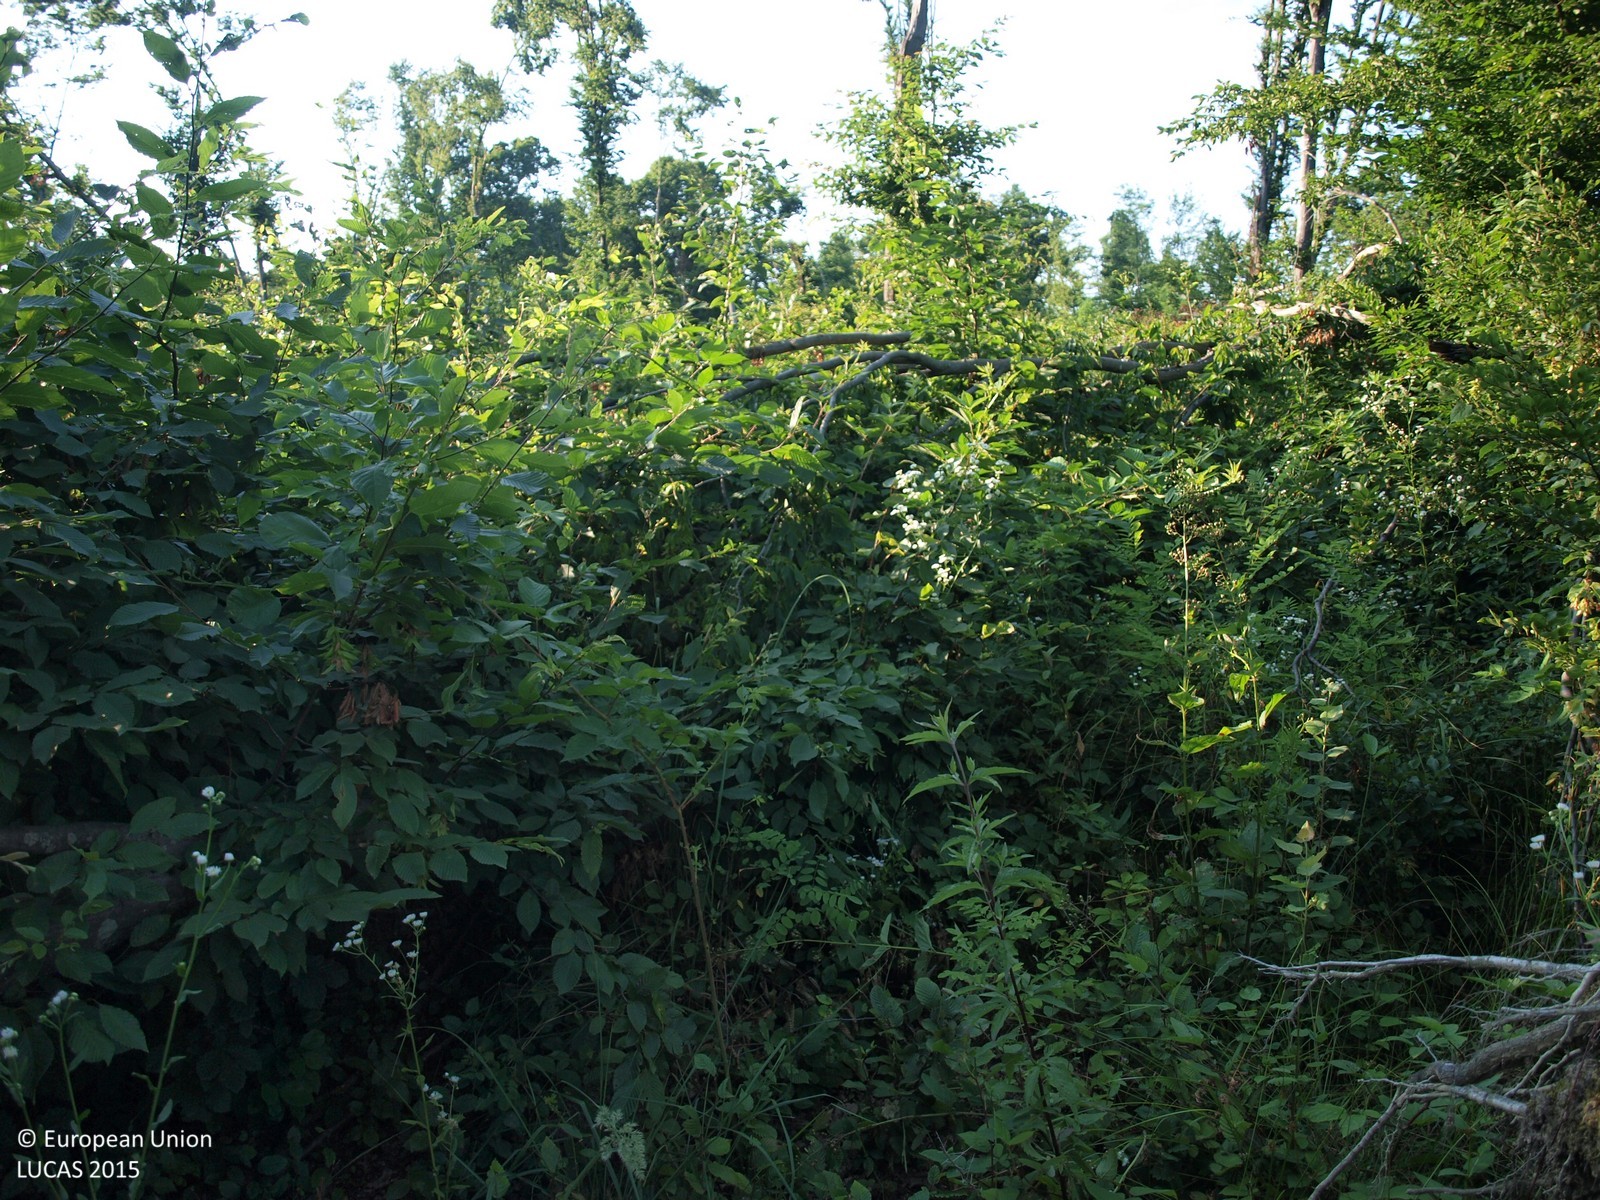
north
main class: Woodland
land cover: Broadleaved woodland
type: mesophytic deciduous forest
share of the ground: > 75 %
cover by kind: broadleaved forest trees 90 %, shrubs 10 %
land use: Forestry
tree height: > 5 m
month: July
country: HR
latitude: 45.6791
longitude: 15.6329
